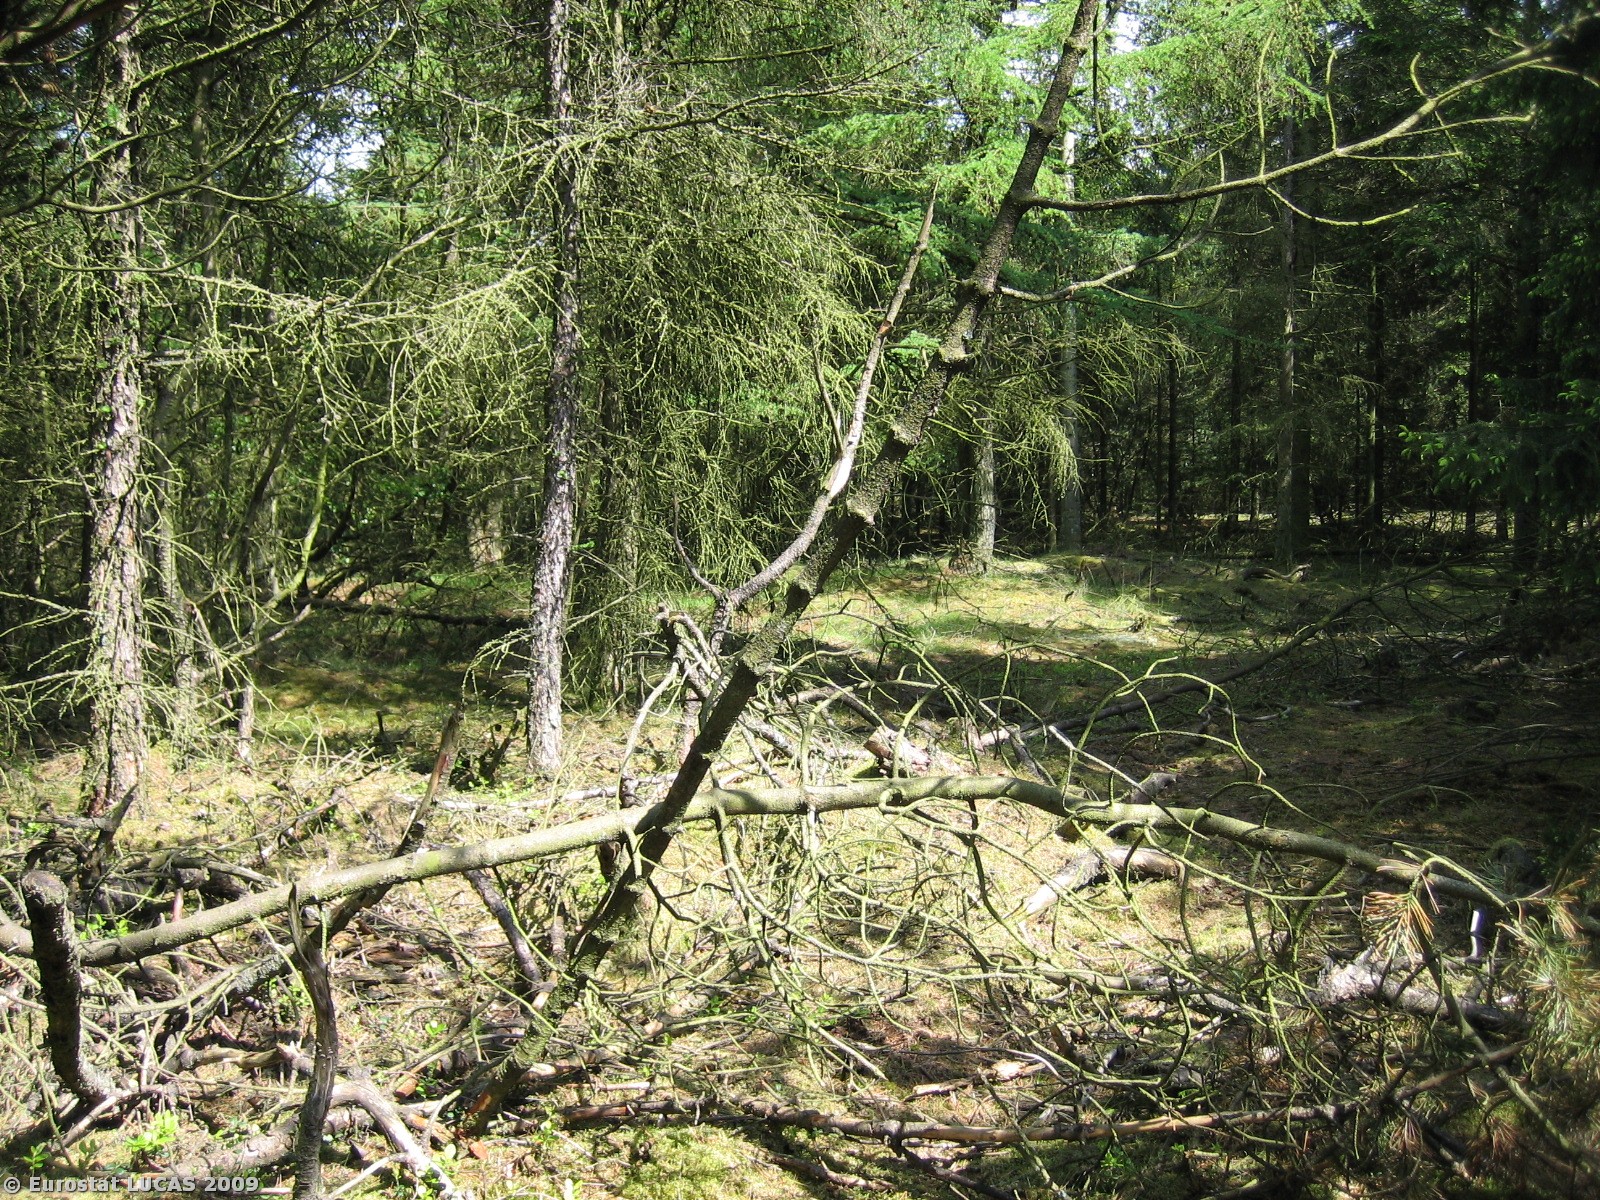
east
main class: Woodland
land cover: Coniferous woodland
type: hemiboreal forest and nemoral coniferous forest and mixed broadleaved-coniferous forest
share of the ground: > 75 %
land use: Forestry
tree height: > 5 m
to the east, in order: Coniferous woodland; Grass margins; Coniferous woodland
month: May
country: DK
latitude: 56.2546
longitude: 8.8553
